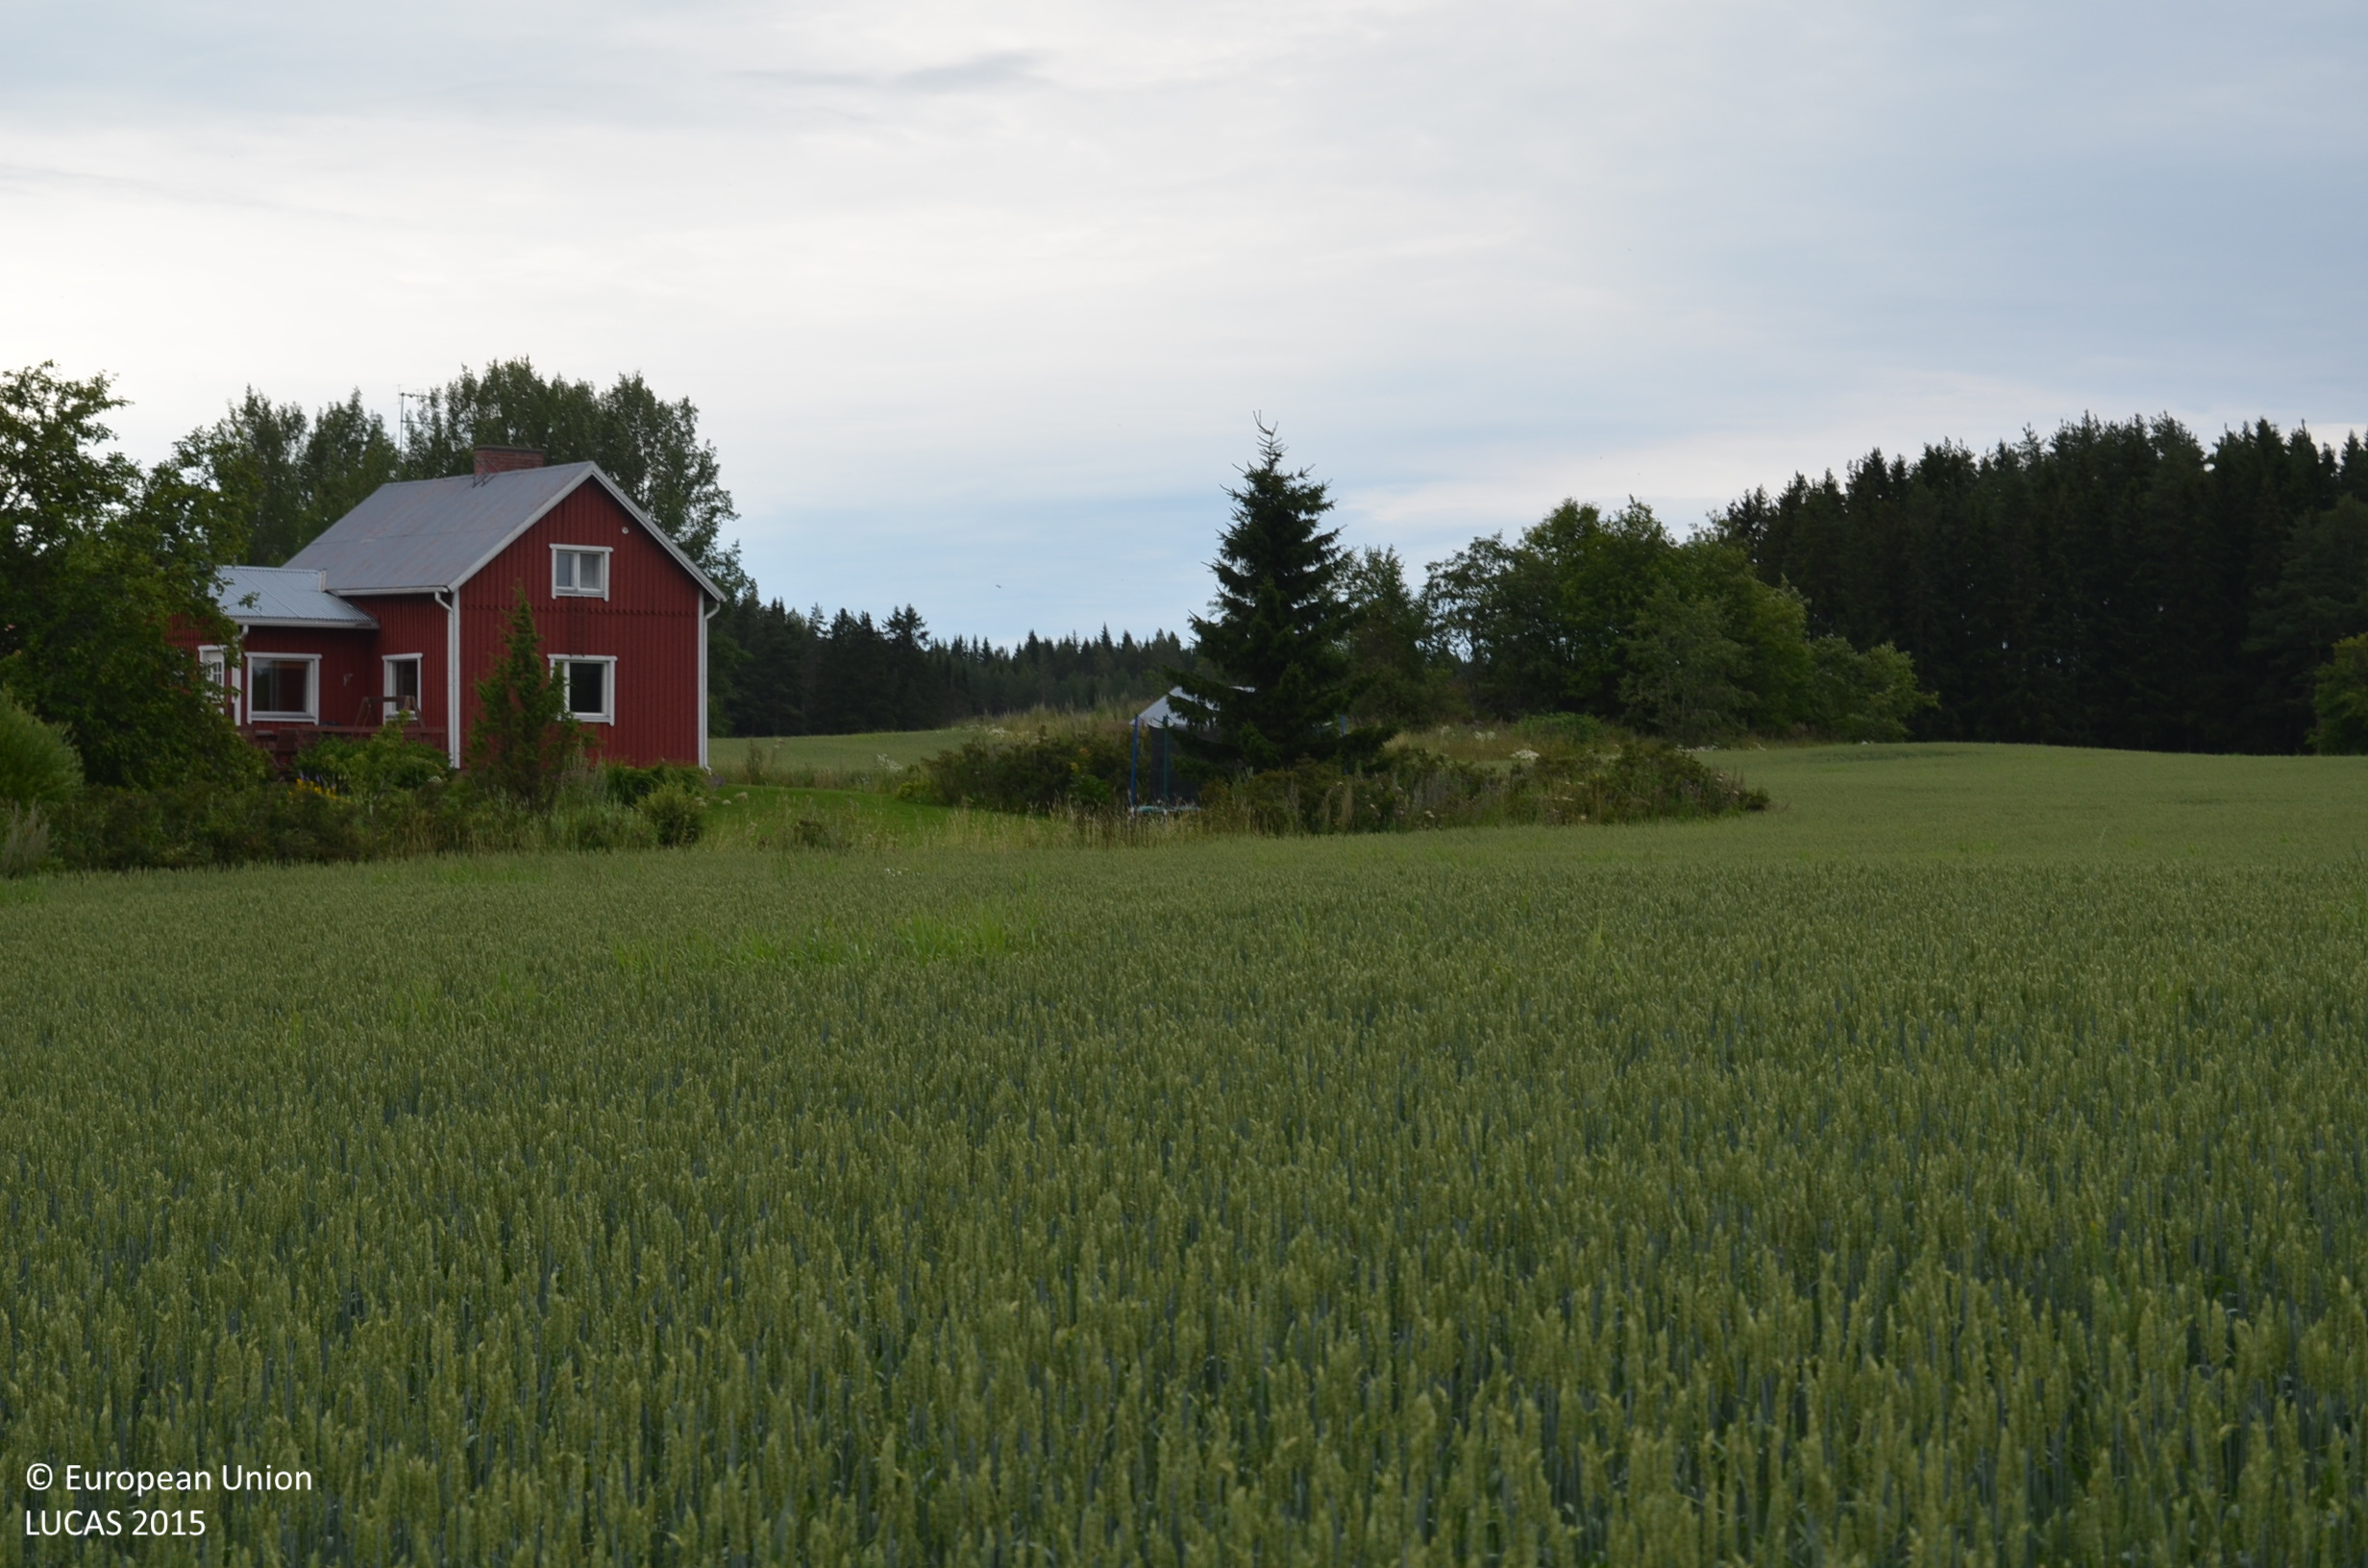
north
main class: Cropland
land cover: Common wheat
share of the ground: > 75 %
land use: Agriculture (excluding fallow land and kitchen gardens)
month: August
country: FI
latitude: 61.4929
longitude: 23.2415
